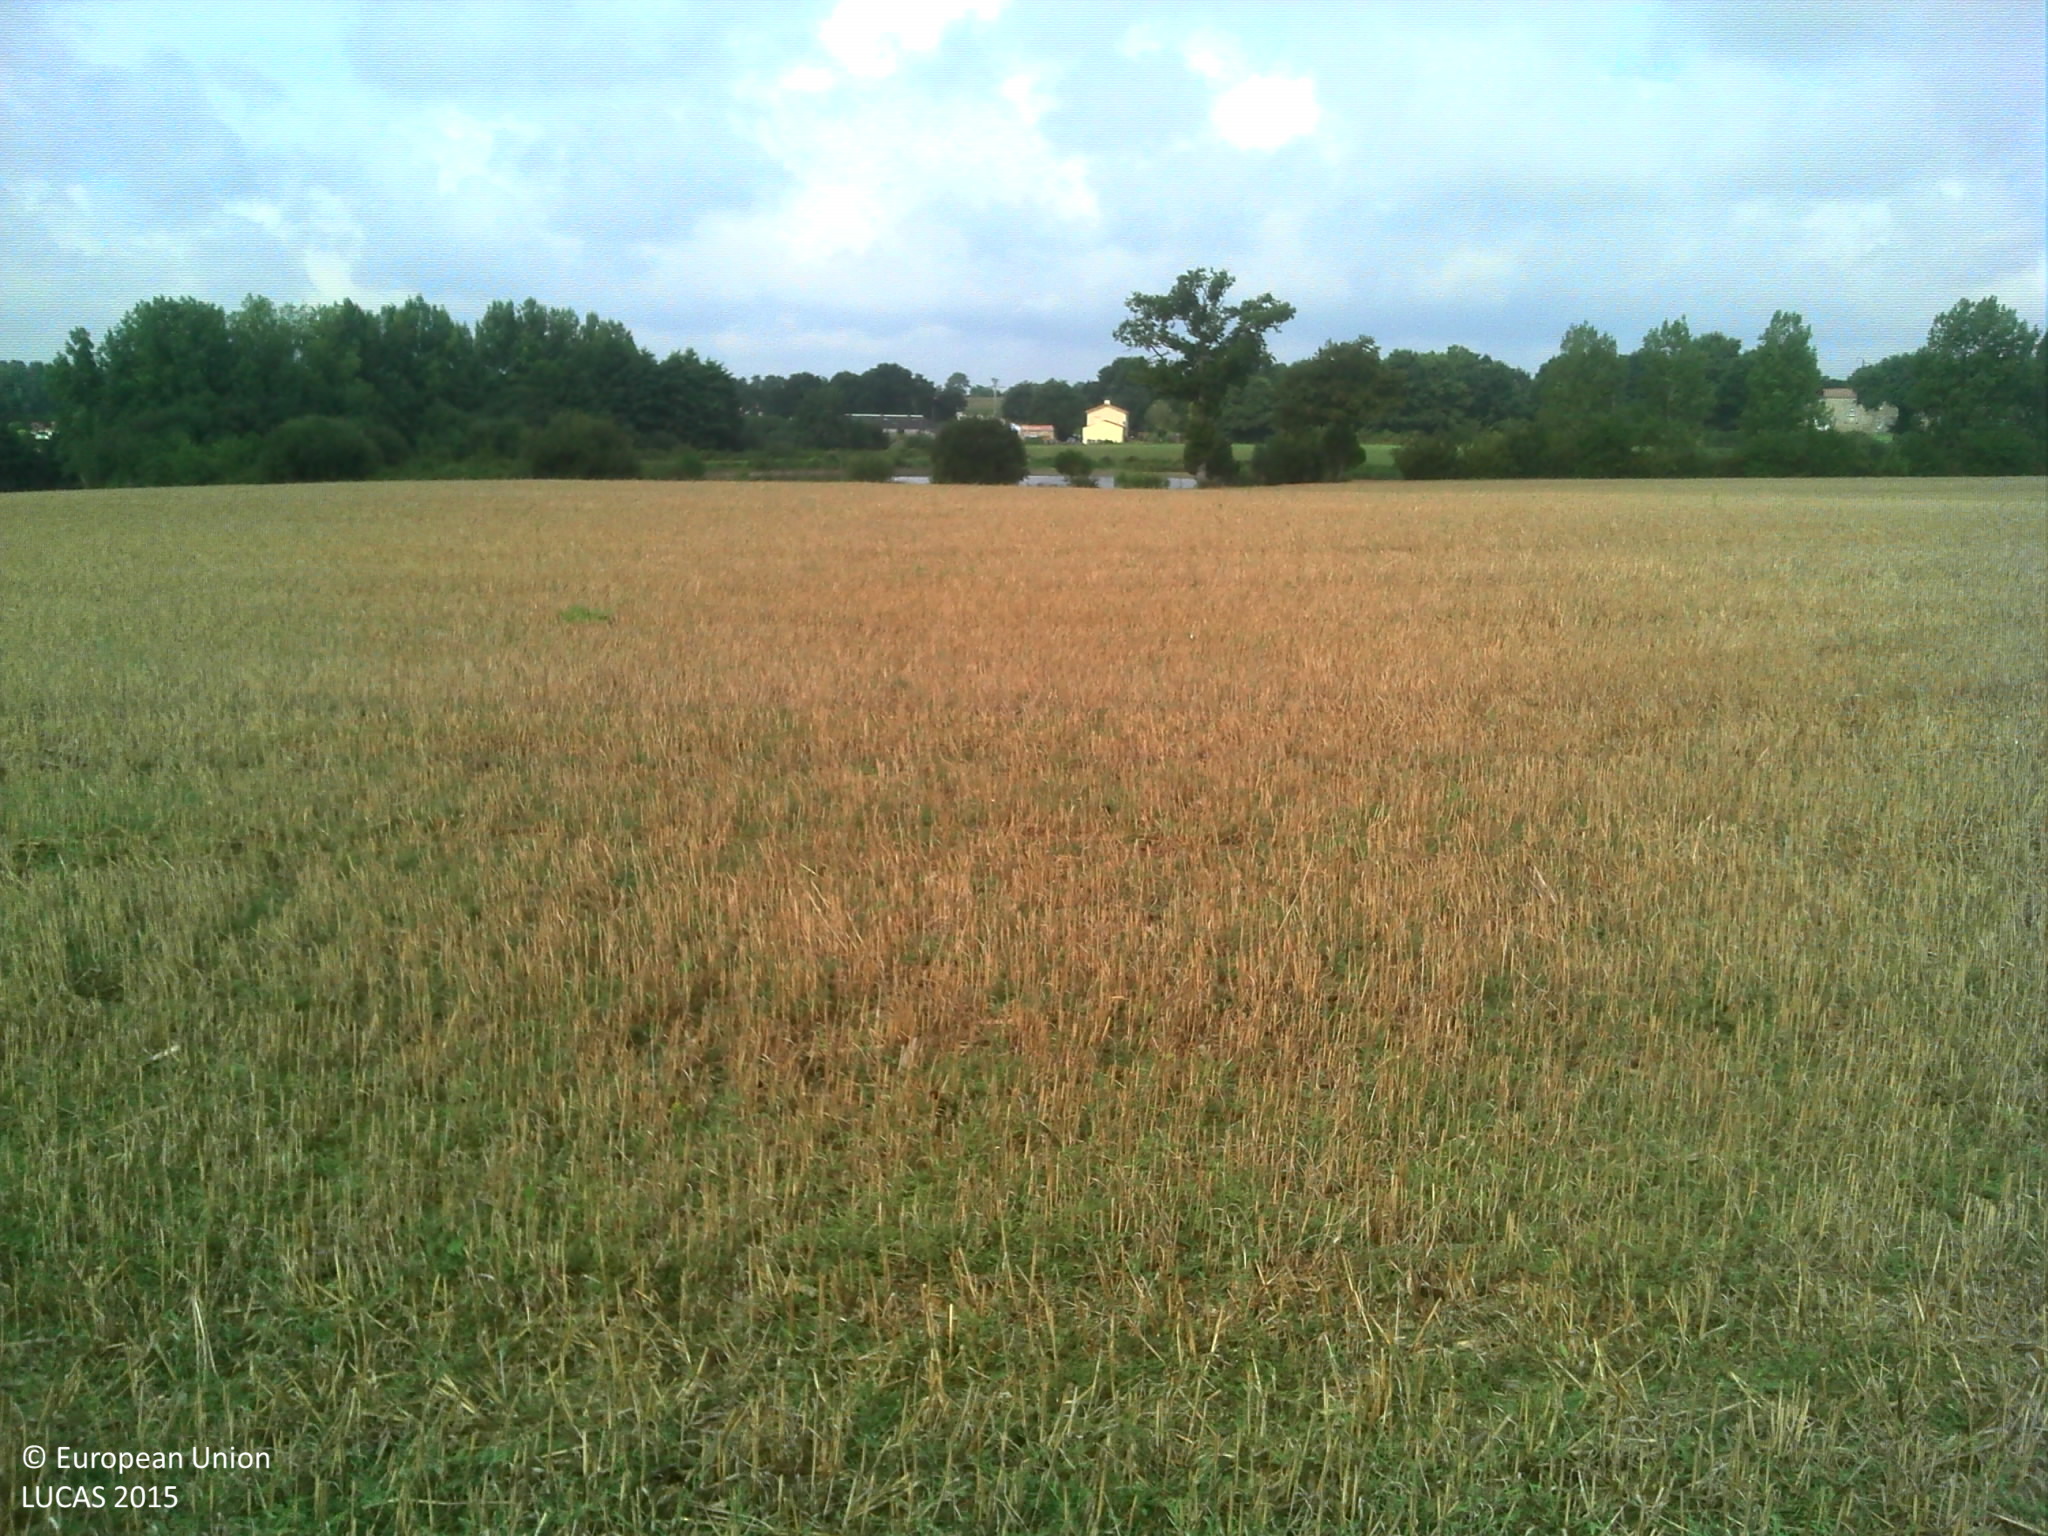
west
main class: Cropland
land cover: Barley
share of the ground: > 75 %
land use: Agriculture (excluding fallow land and kitchen gardens)
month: August
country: FR
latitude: 46.6656
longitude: -1.5804
